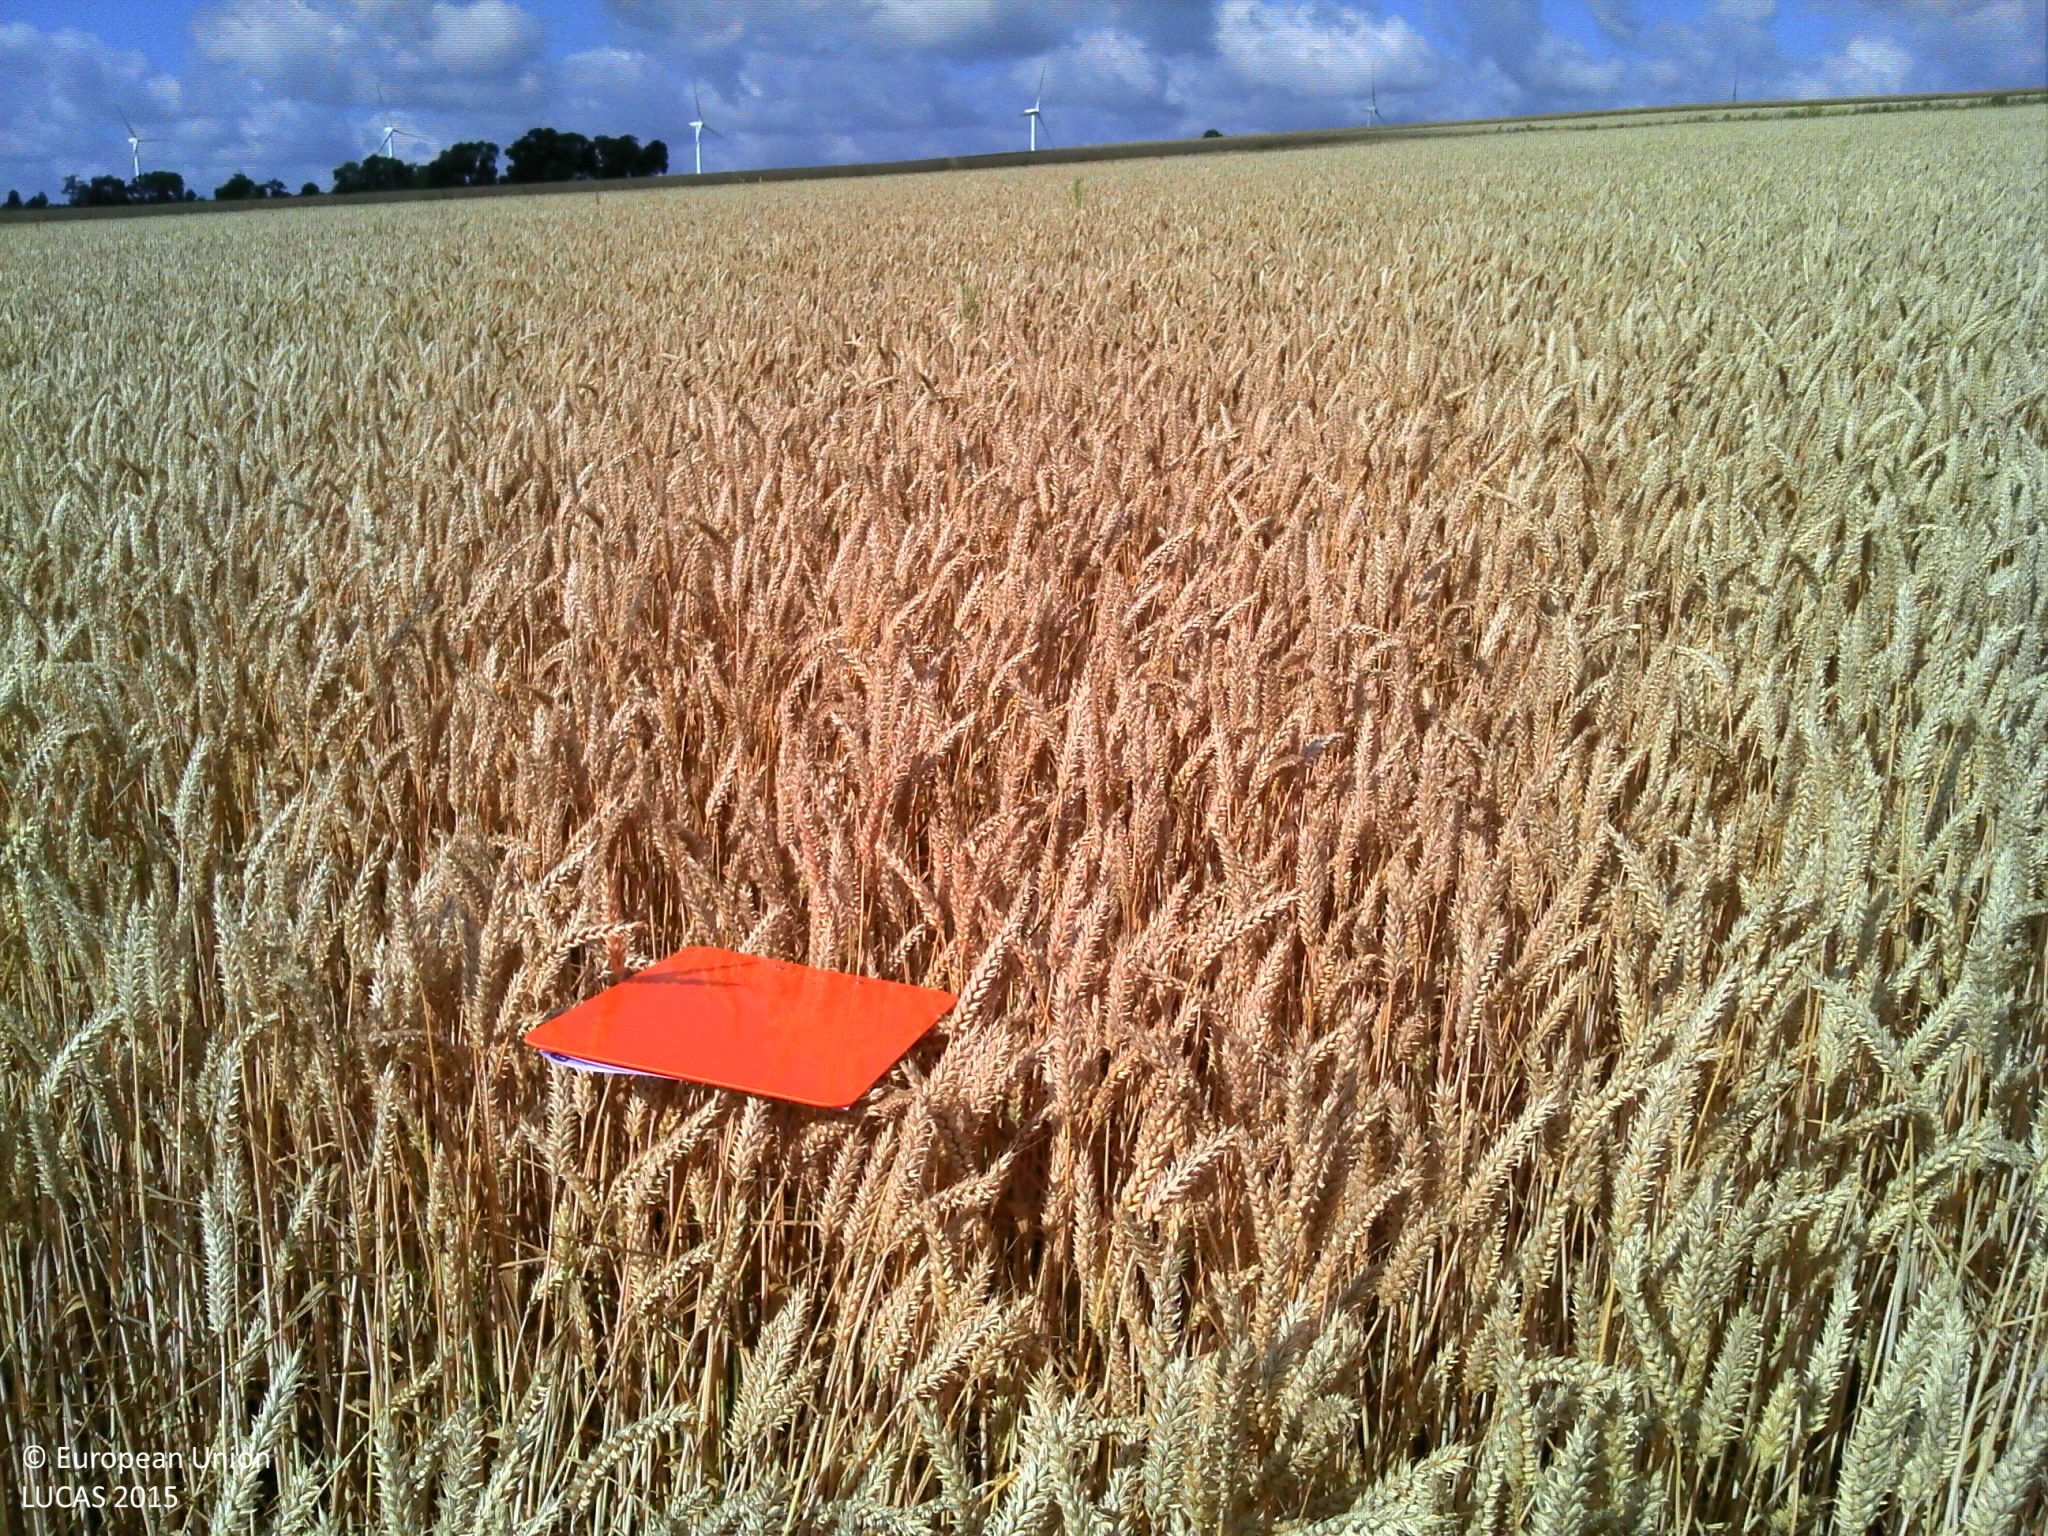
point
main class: Cropland
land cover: Common wheat
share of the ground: > 75 %
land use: Agriculture (excluding fallow land and kitchen gardens)
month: July
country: FR
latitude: 48.9481
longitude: -0.1778
